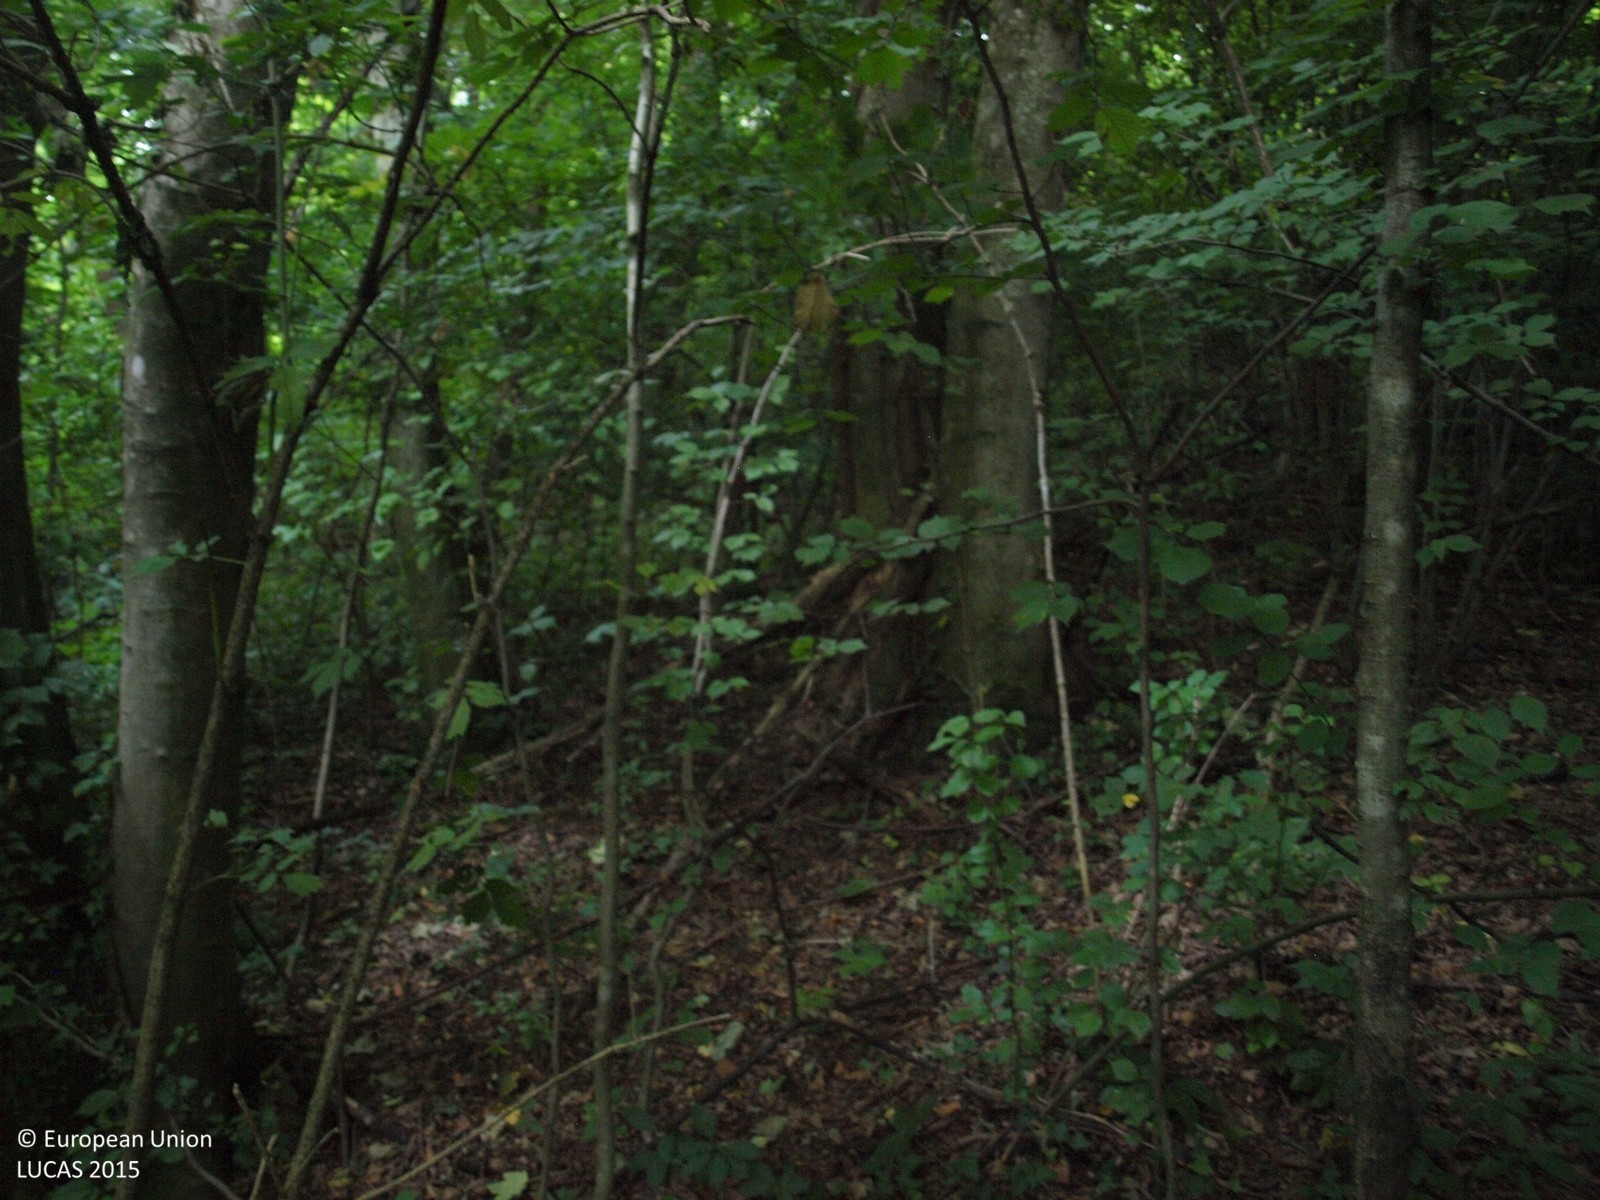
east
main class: Woodland
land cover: Broadleaved woodland
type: beech forest
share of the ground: > 75 %
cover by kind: broadleaved forest trees 100 %
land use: Forestry
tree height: > 5 m
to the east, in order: Broadleaved woodland; Paved roads, cycling and walking lanes; Broadleaved woodland; Grassland without tree/shrub cover; Broadleaved woodland
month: July
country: HR
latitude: 46.2196
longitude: 16.5992
